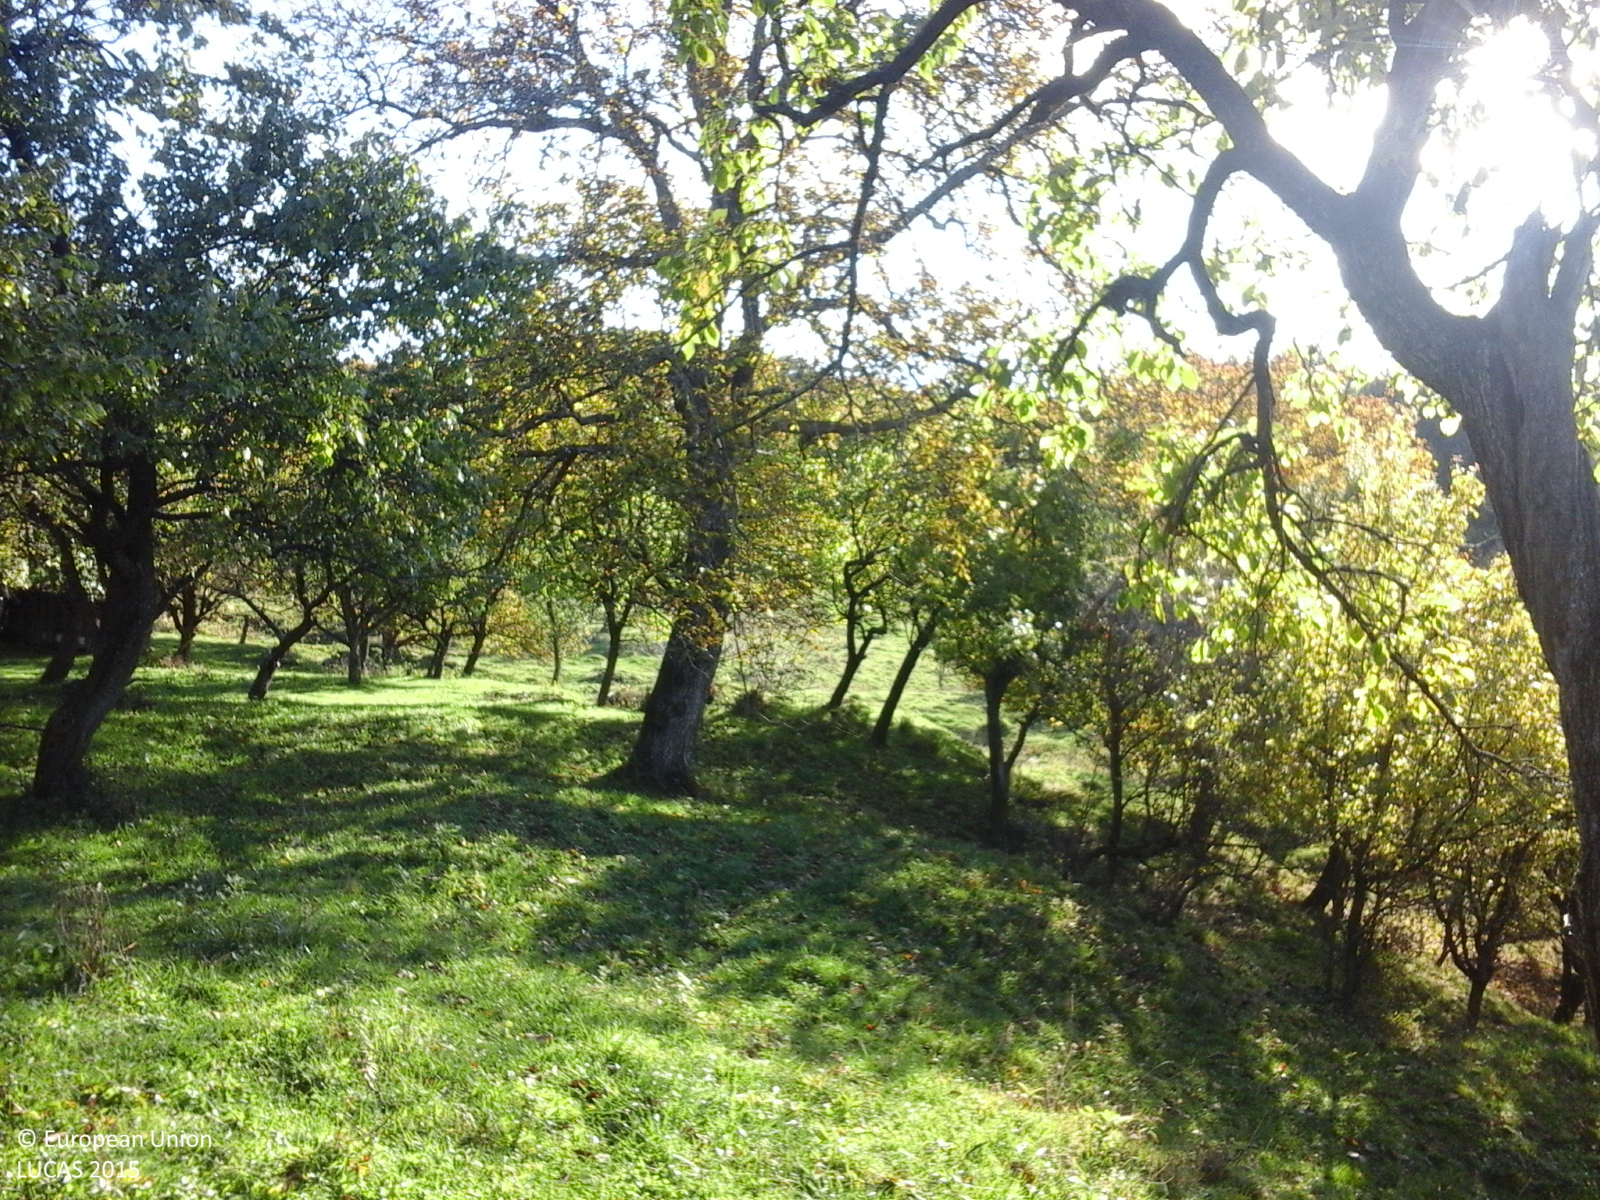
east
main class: Cropland
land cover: Other fruit trees and berries
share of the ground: > 75 %
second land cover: Grassland without tree/shrub cover
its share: > 75 %
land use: Agriculture (excluding fallow land and kitchen gardens)
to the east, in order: Other fruit trees and berries; Grassland without tree/shrub cover; Grassland with sparse tree/shrub cover; Grassland without tree/shrub cover; Broadleaved woodland
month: October
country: RO
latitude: 45.2301
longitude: 25.1327
